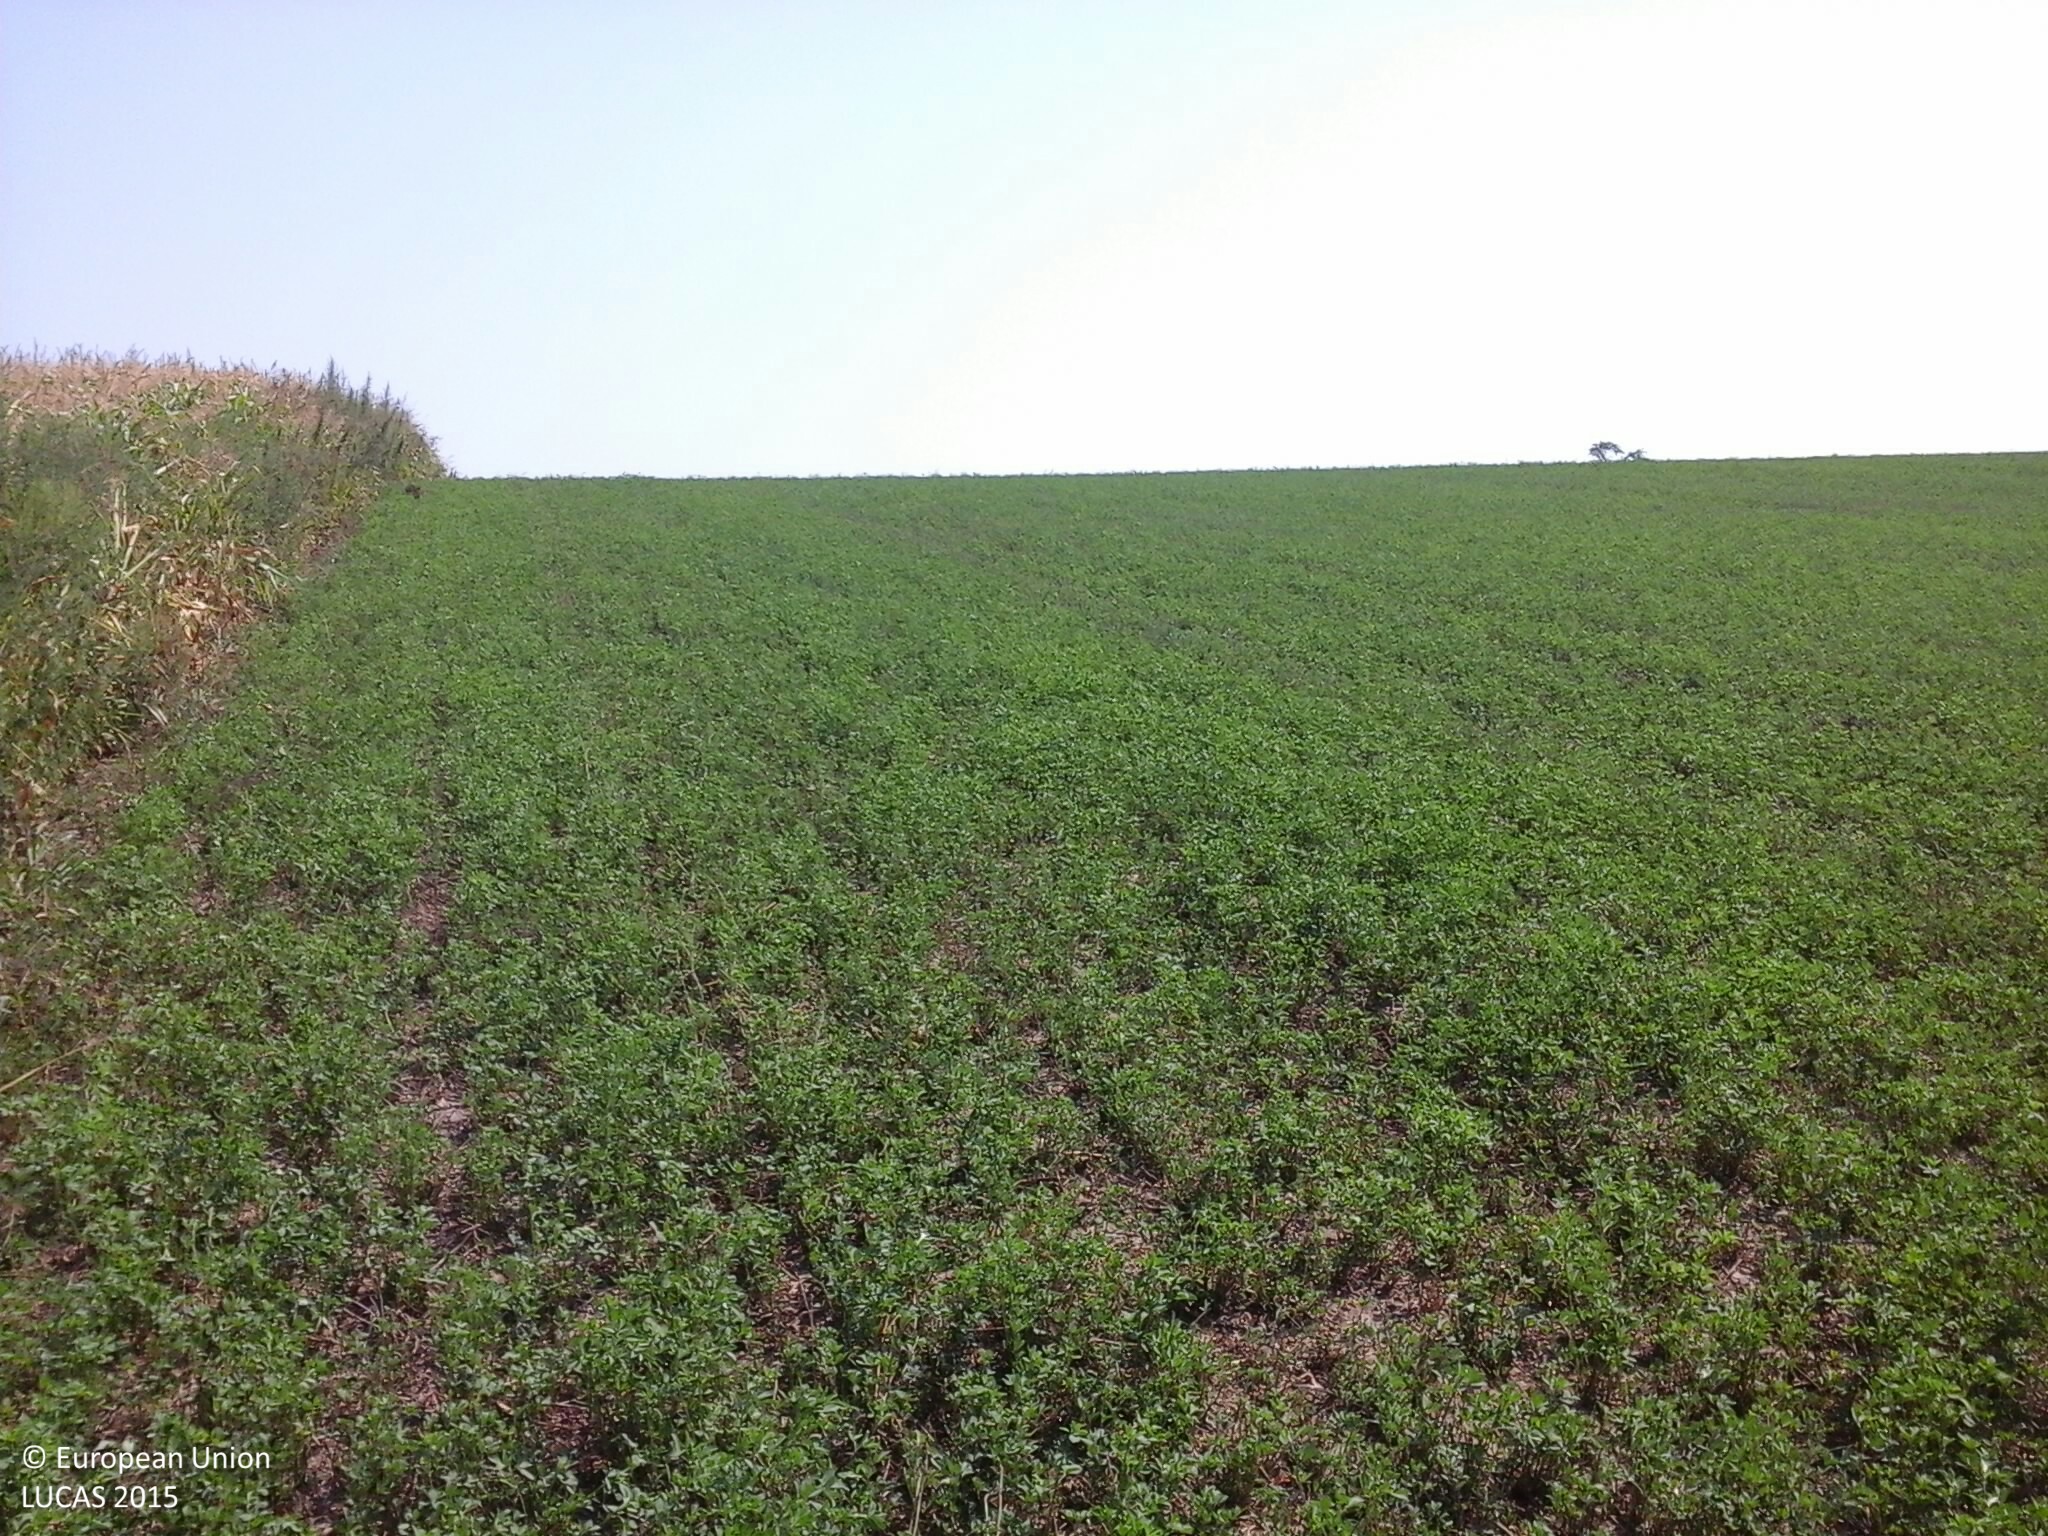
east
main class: Cropland
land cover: Maize
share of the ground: > 75 %
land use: Agriculture (excluding fallow land and kitchen gardens)
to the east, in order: Maize; Lucerne; Spontaneously vegetated surfaces; Tracks; Spontaneously vegetated surfaces; Maize
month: August
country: HU
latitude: 46.8439
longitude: 18.2846
